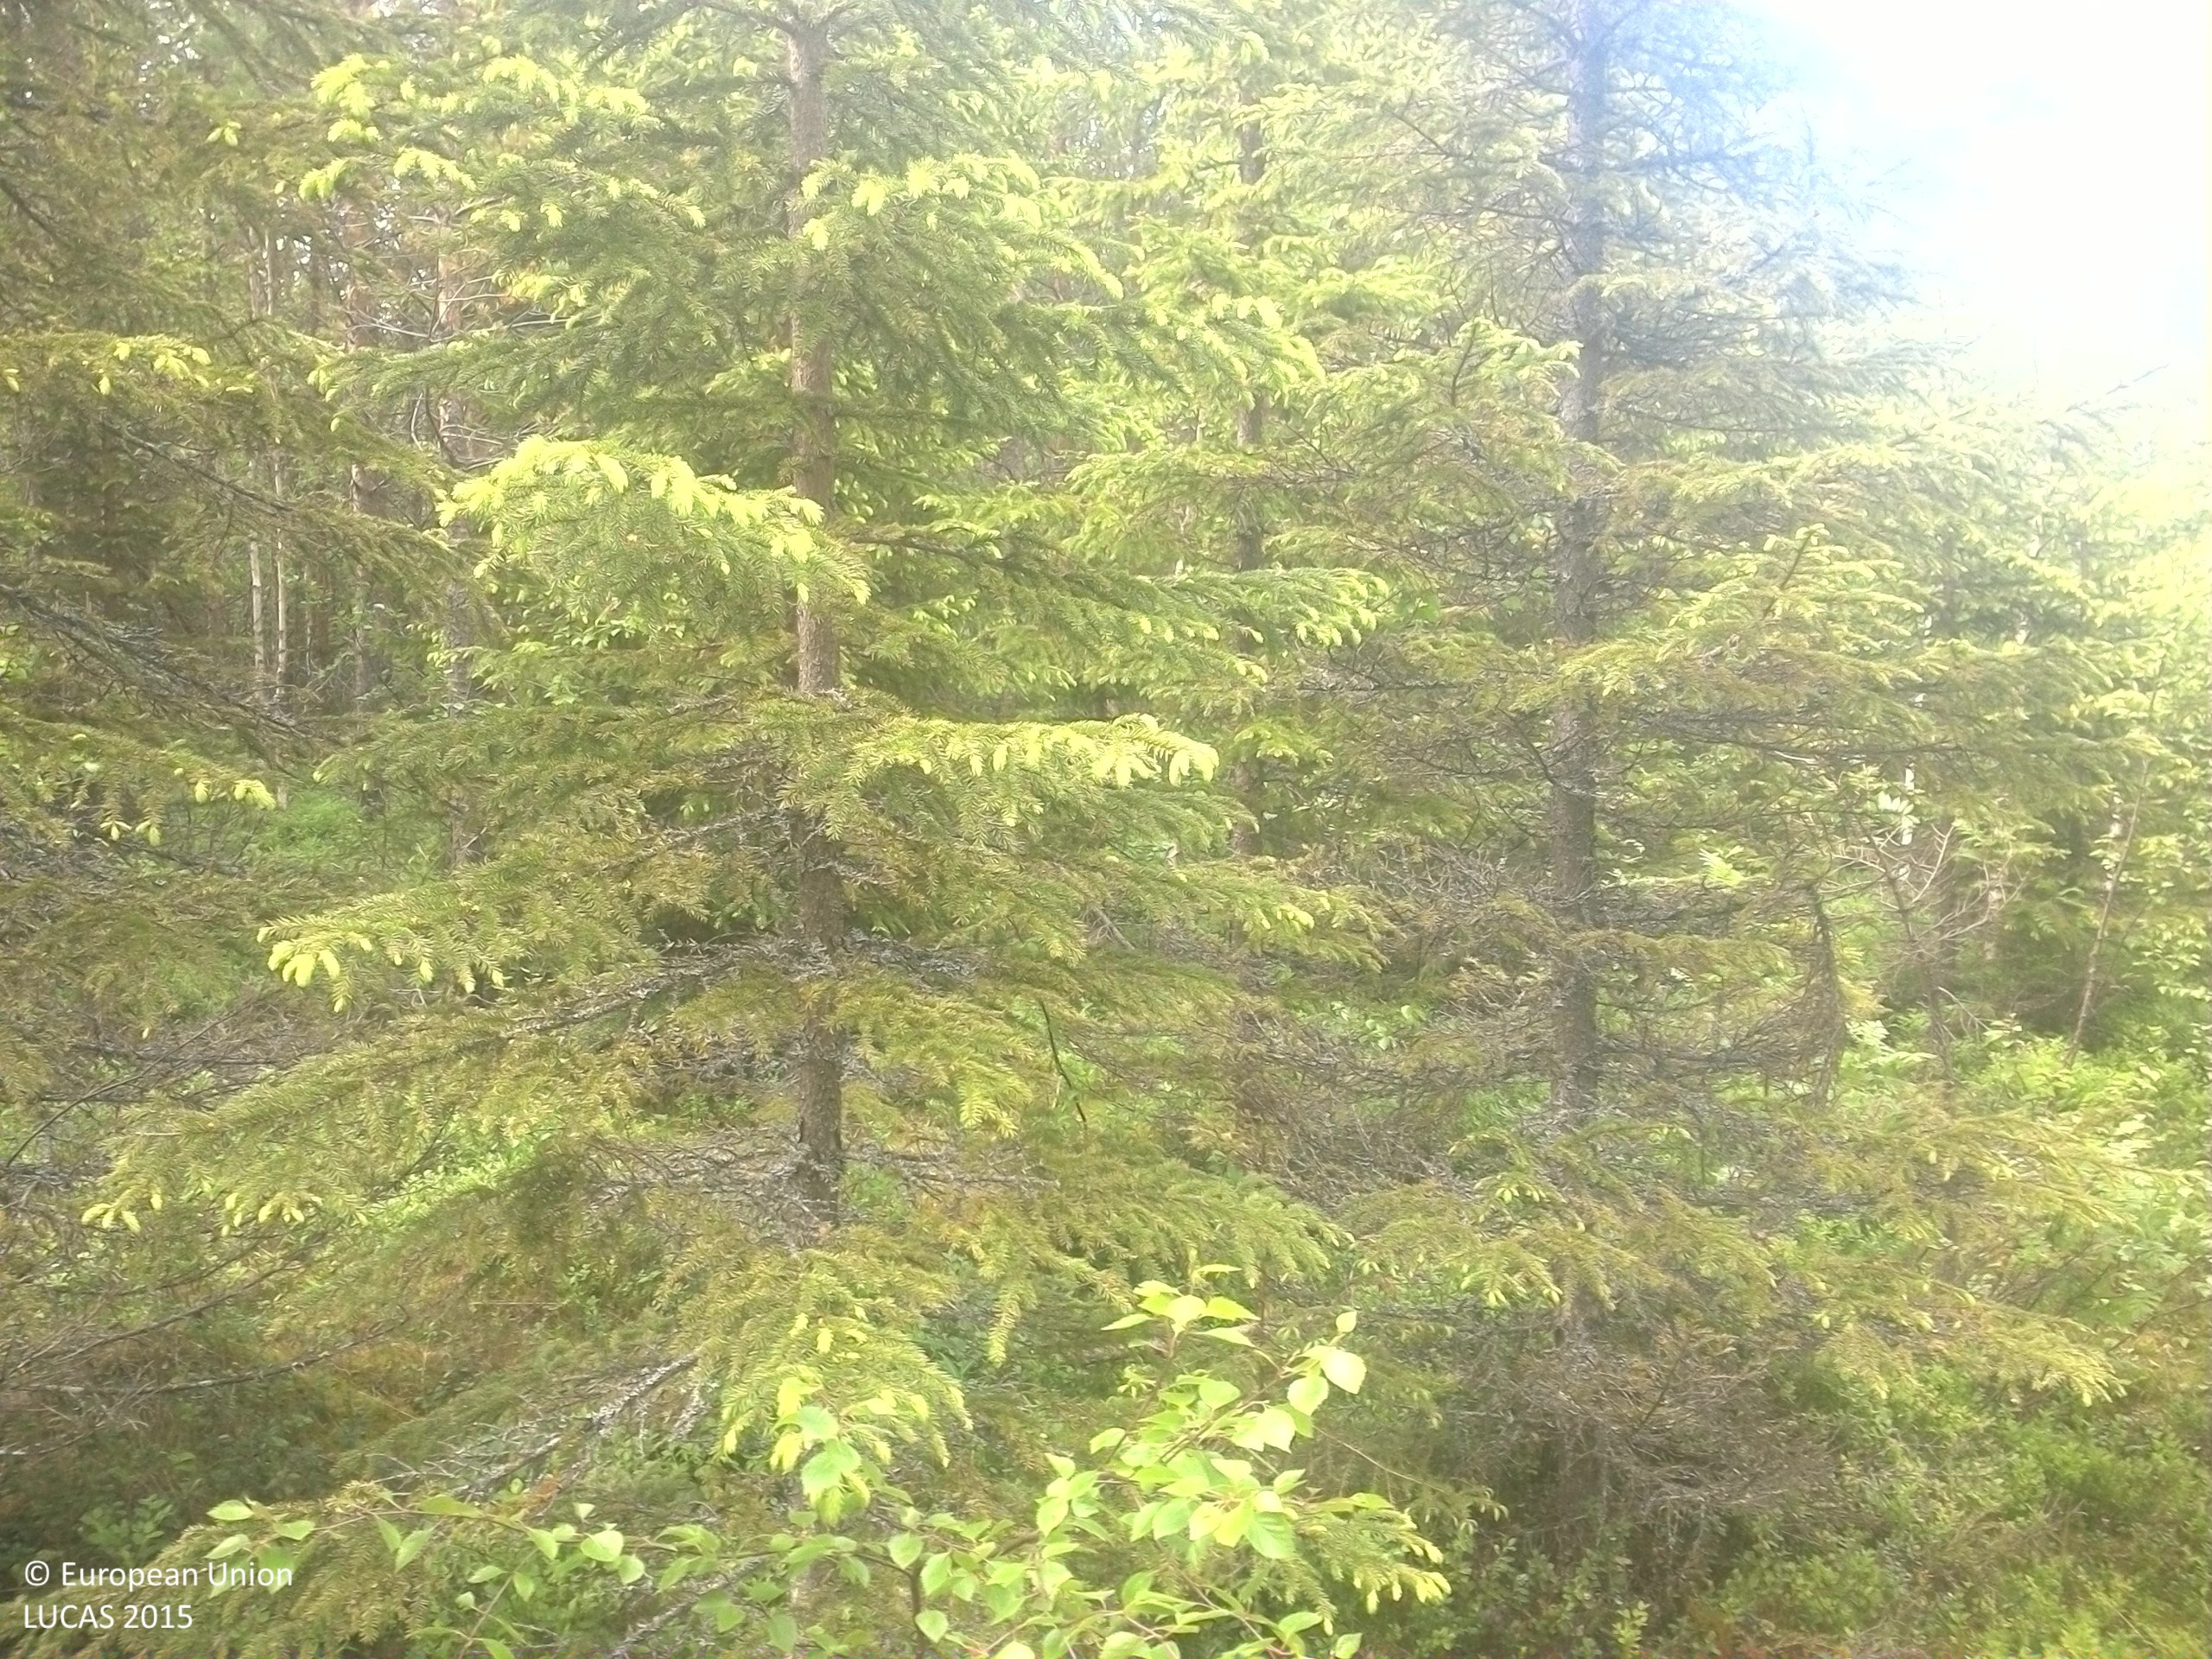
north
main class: Woodland
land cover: Spruce dominated mixed woodland
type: boreal forest
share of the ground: > 75 %
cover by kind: coniferous forest trees 55 %, shrubs 25 %, broadleaved forest trees 20 %
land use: Forestry
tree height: > 5 m
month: June
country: SE
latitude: 63.4611
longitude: 17.8183
